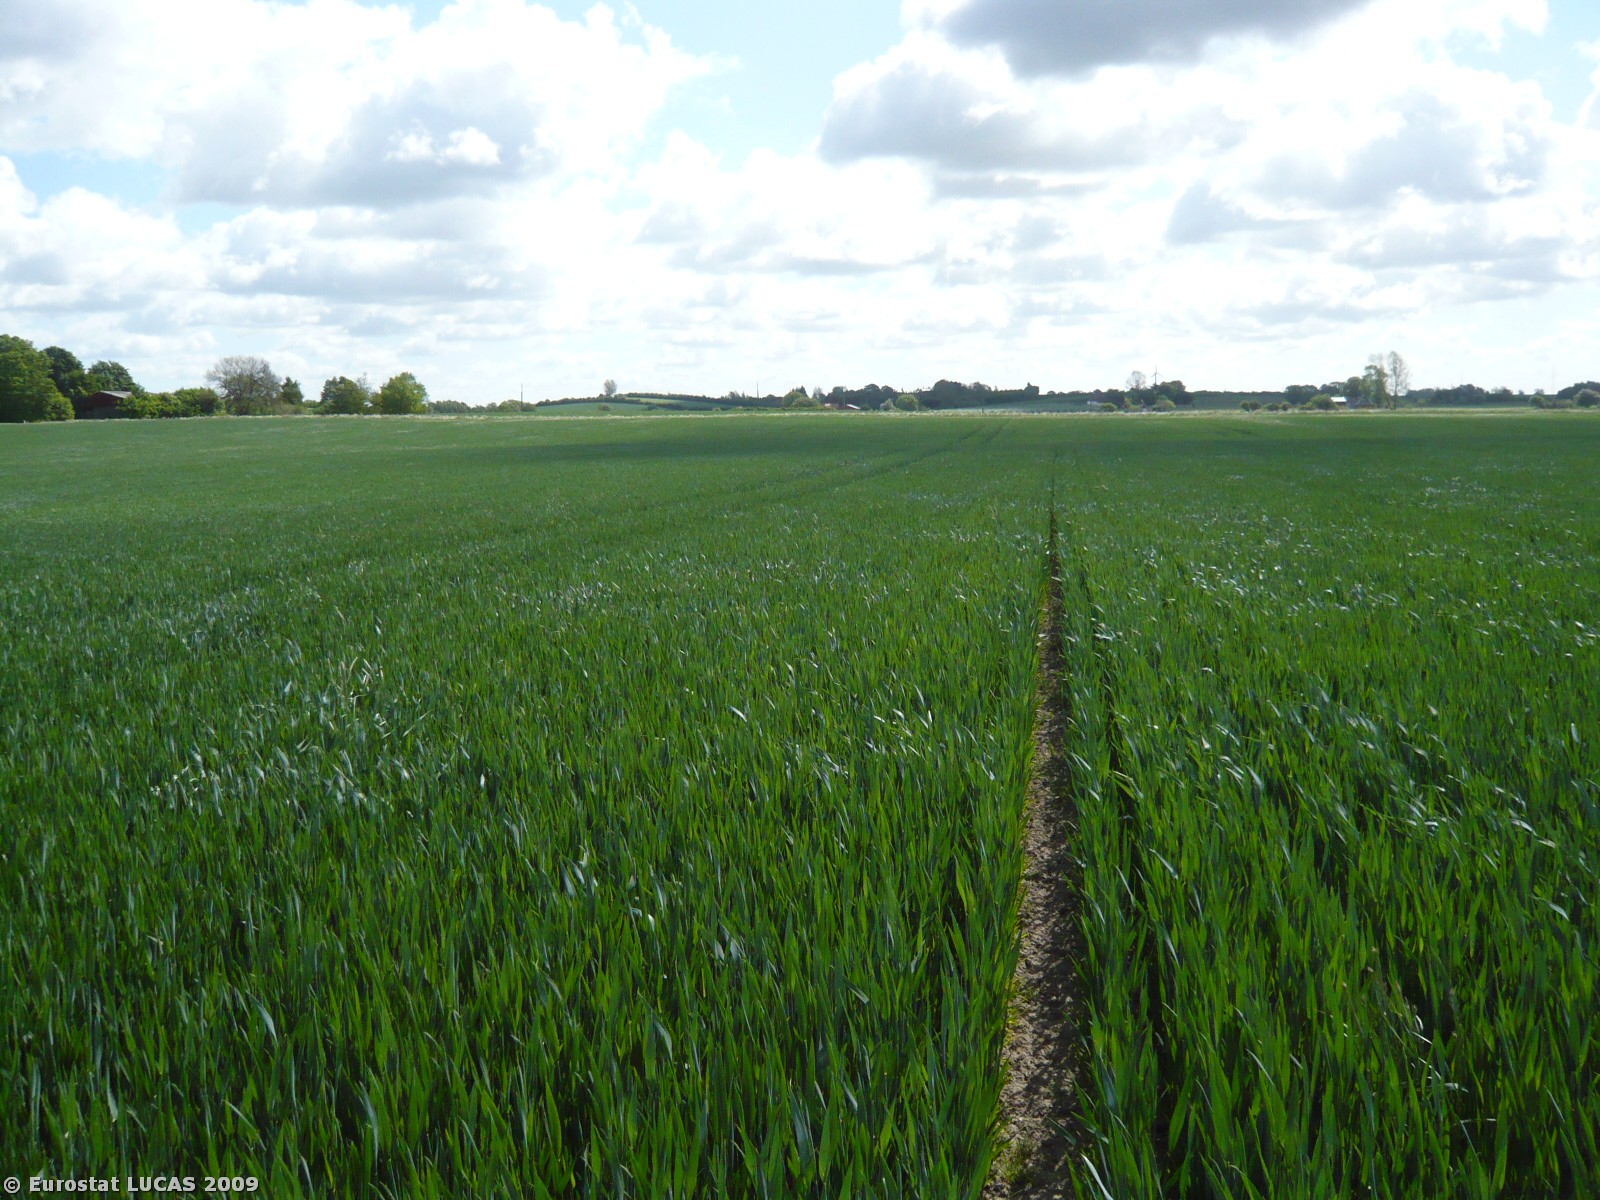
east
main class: Cropland
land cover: Common wheat
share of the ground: > 75 %
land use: Agriculture (excluding fallow land and kitchen gardens)
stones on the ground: < 10 %
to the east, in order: Common wheat; Grass margins; Paved roads, cycling and walking lanes; Grass margins; Common wheat
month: May
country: DK
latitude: 55.2782
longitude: 11.6516
